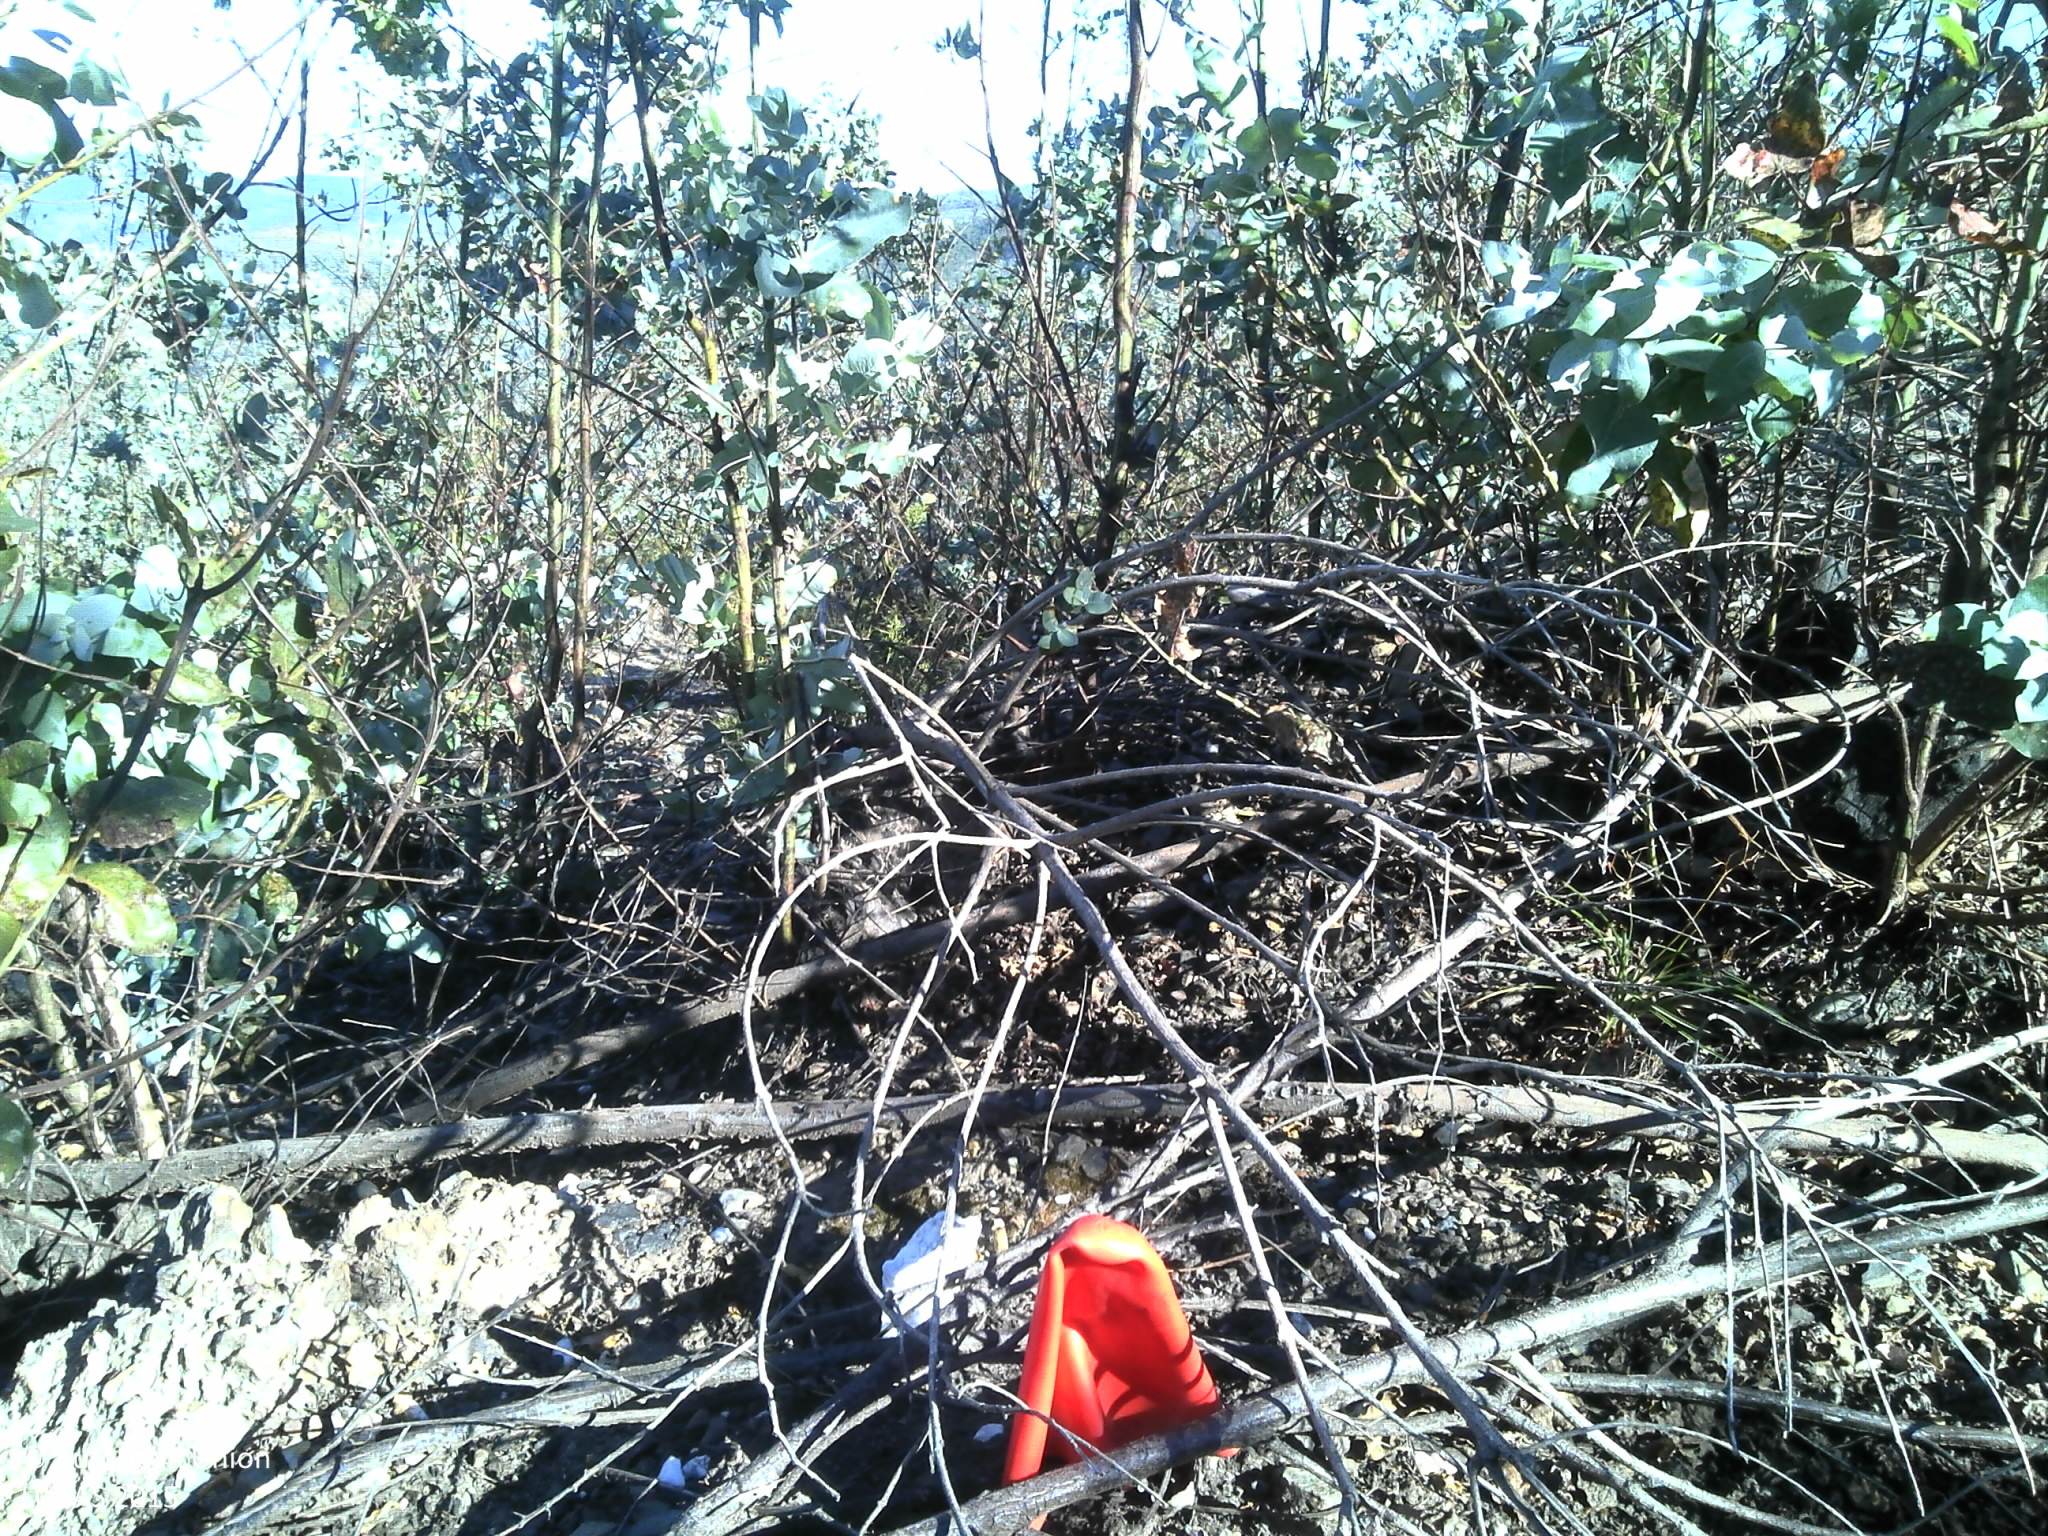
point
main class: Woodland
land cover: Broadleaved woodland
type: exotic forest
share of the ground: 25 - 50 %
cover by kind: unconsolidated bare surface 65 %, broadleaved forest trees 25 %, shrubs 10 %
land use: Forestry
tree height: < 5 m
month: June
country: PT
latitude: 40.5483
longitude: -8.2818
